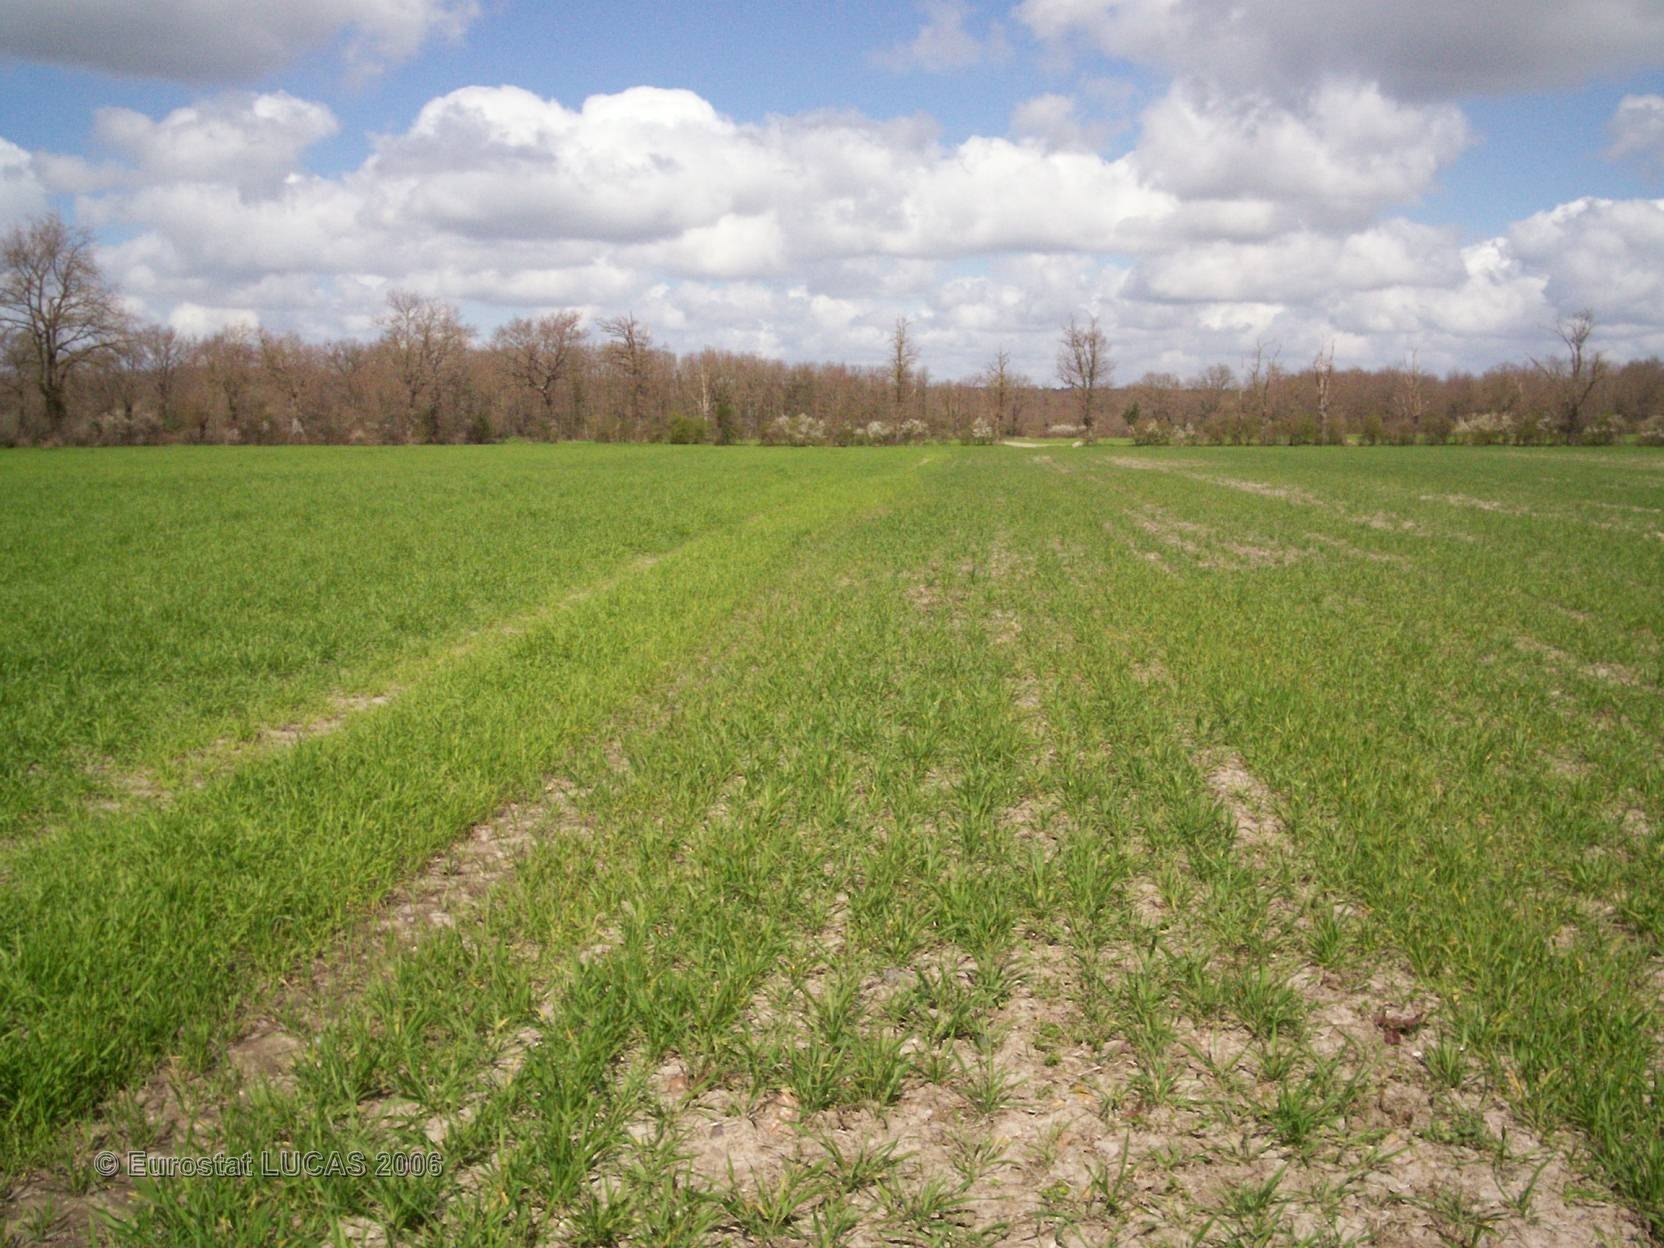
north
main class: Cropland
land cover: Barley
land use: Agriculture (excluding fallow land and kitchen gardens)
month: April
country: FR
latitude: 46.7776
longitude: -0.3070
